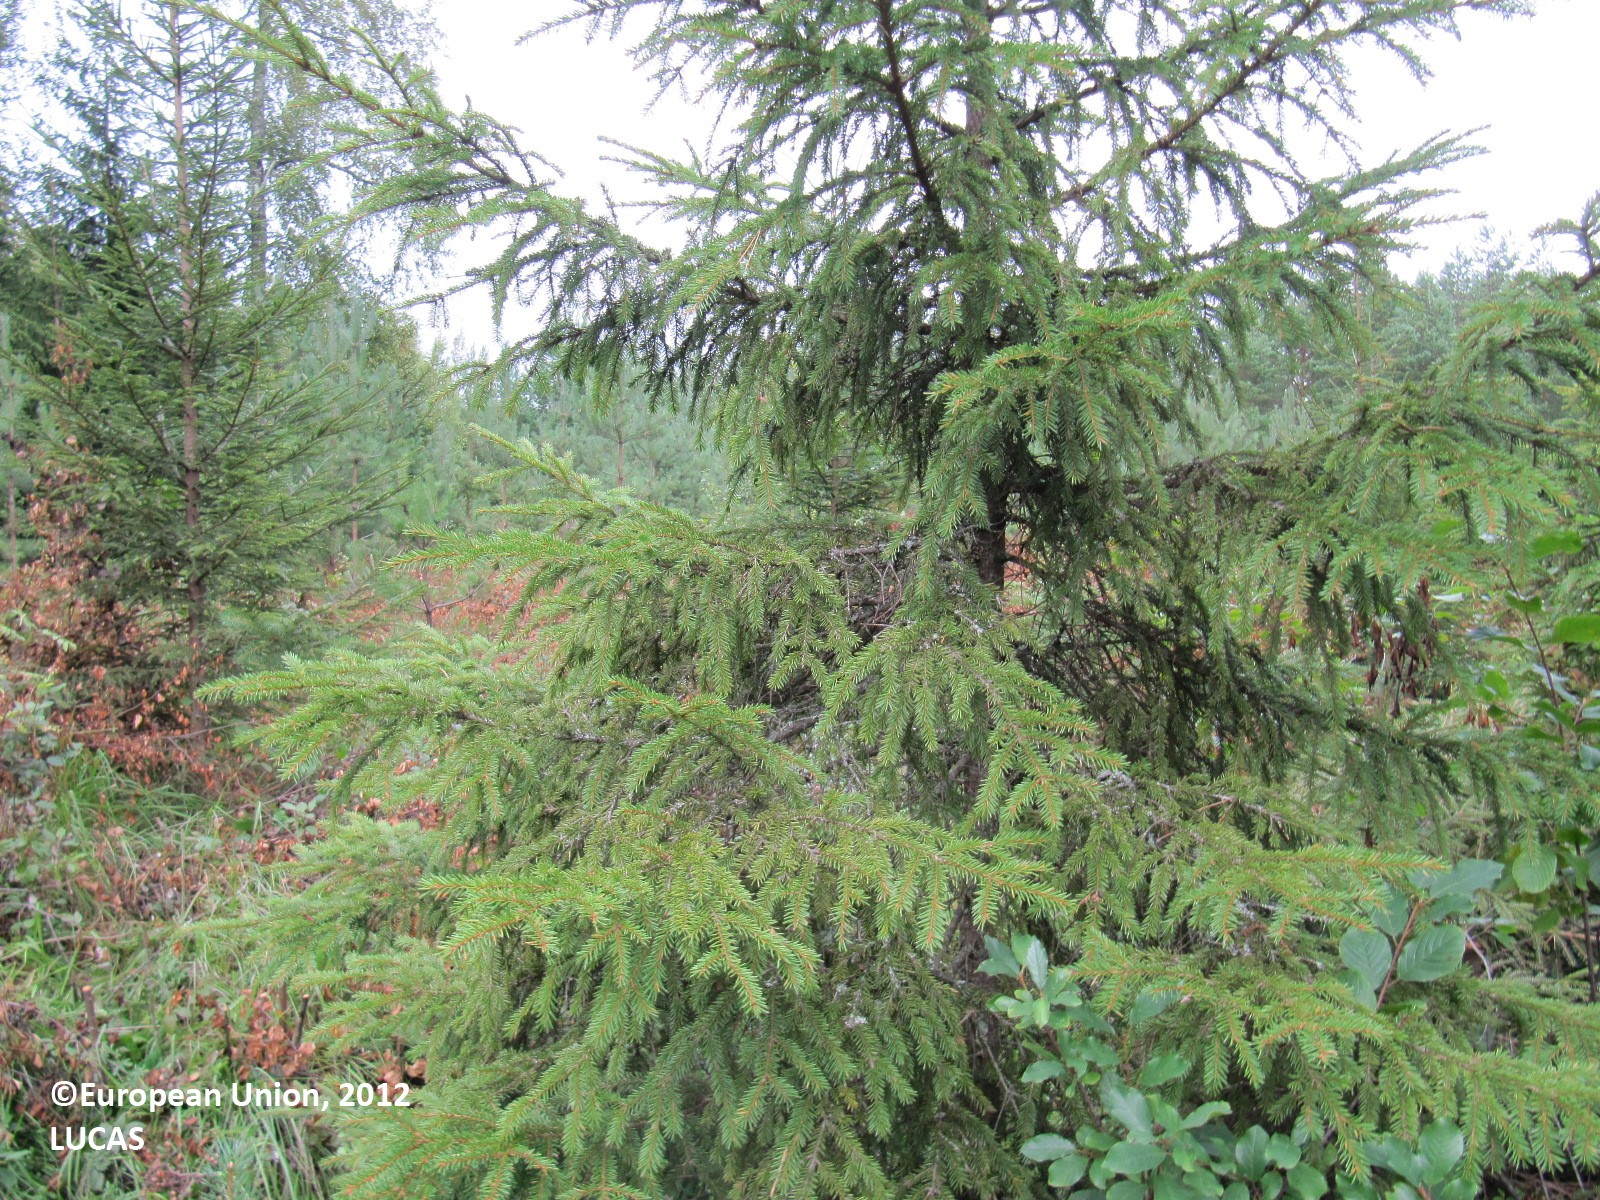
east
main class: Woodland
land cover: Pine dominated mixed woodland
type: boreal forest
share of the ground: > 75 %
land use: Forestry
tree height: > 5 m
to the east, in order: Pine dominated mixed woodland; Pine dominated coniferous woodland; Ditches and canals; Grass margins; Paved roads, cycling and walking lanes; Ditches and canals; Pine dominated mixed woodland; Shrubland with sparse tree cover; Electric lines; Shrubland with sparse tree cover; Pine dominated mixed woodland
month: August
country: FI
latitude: 60.2458
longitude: 23.0691
